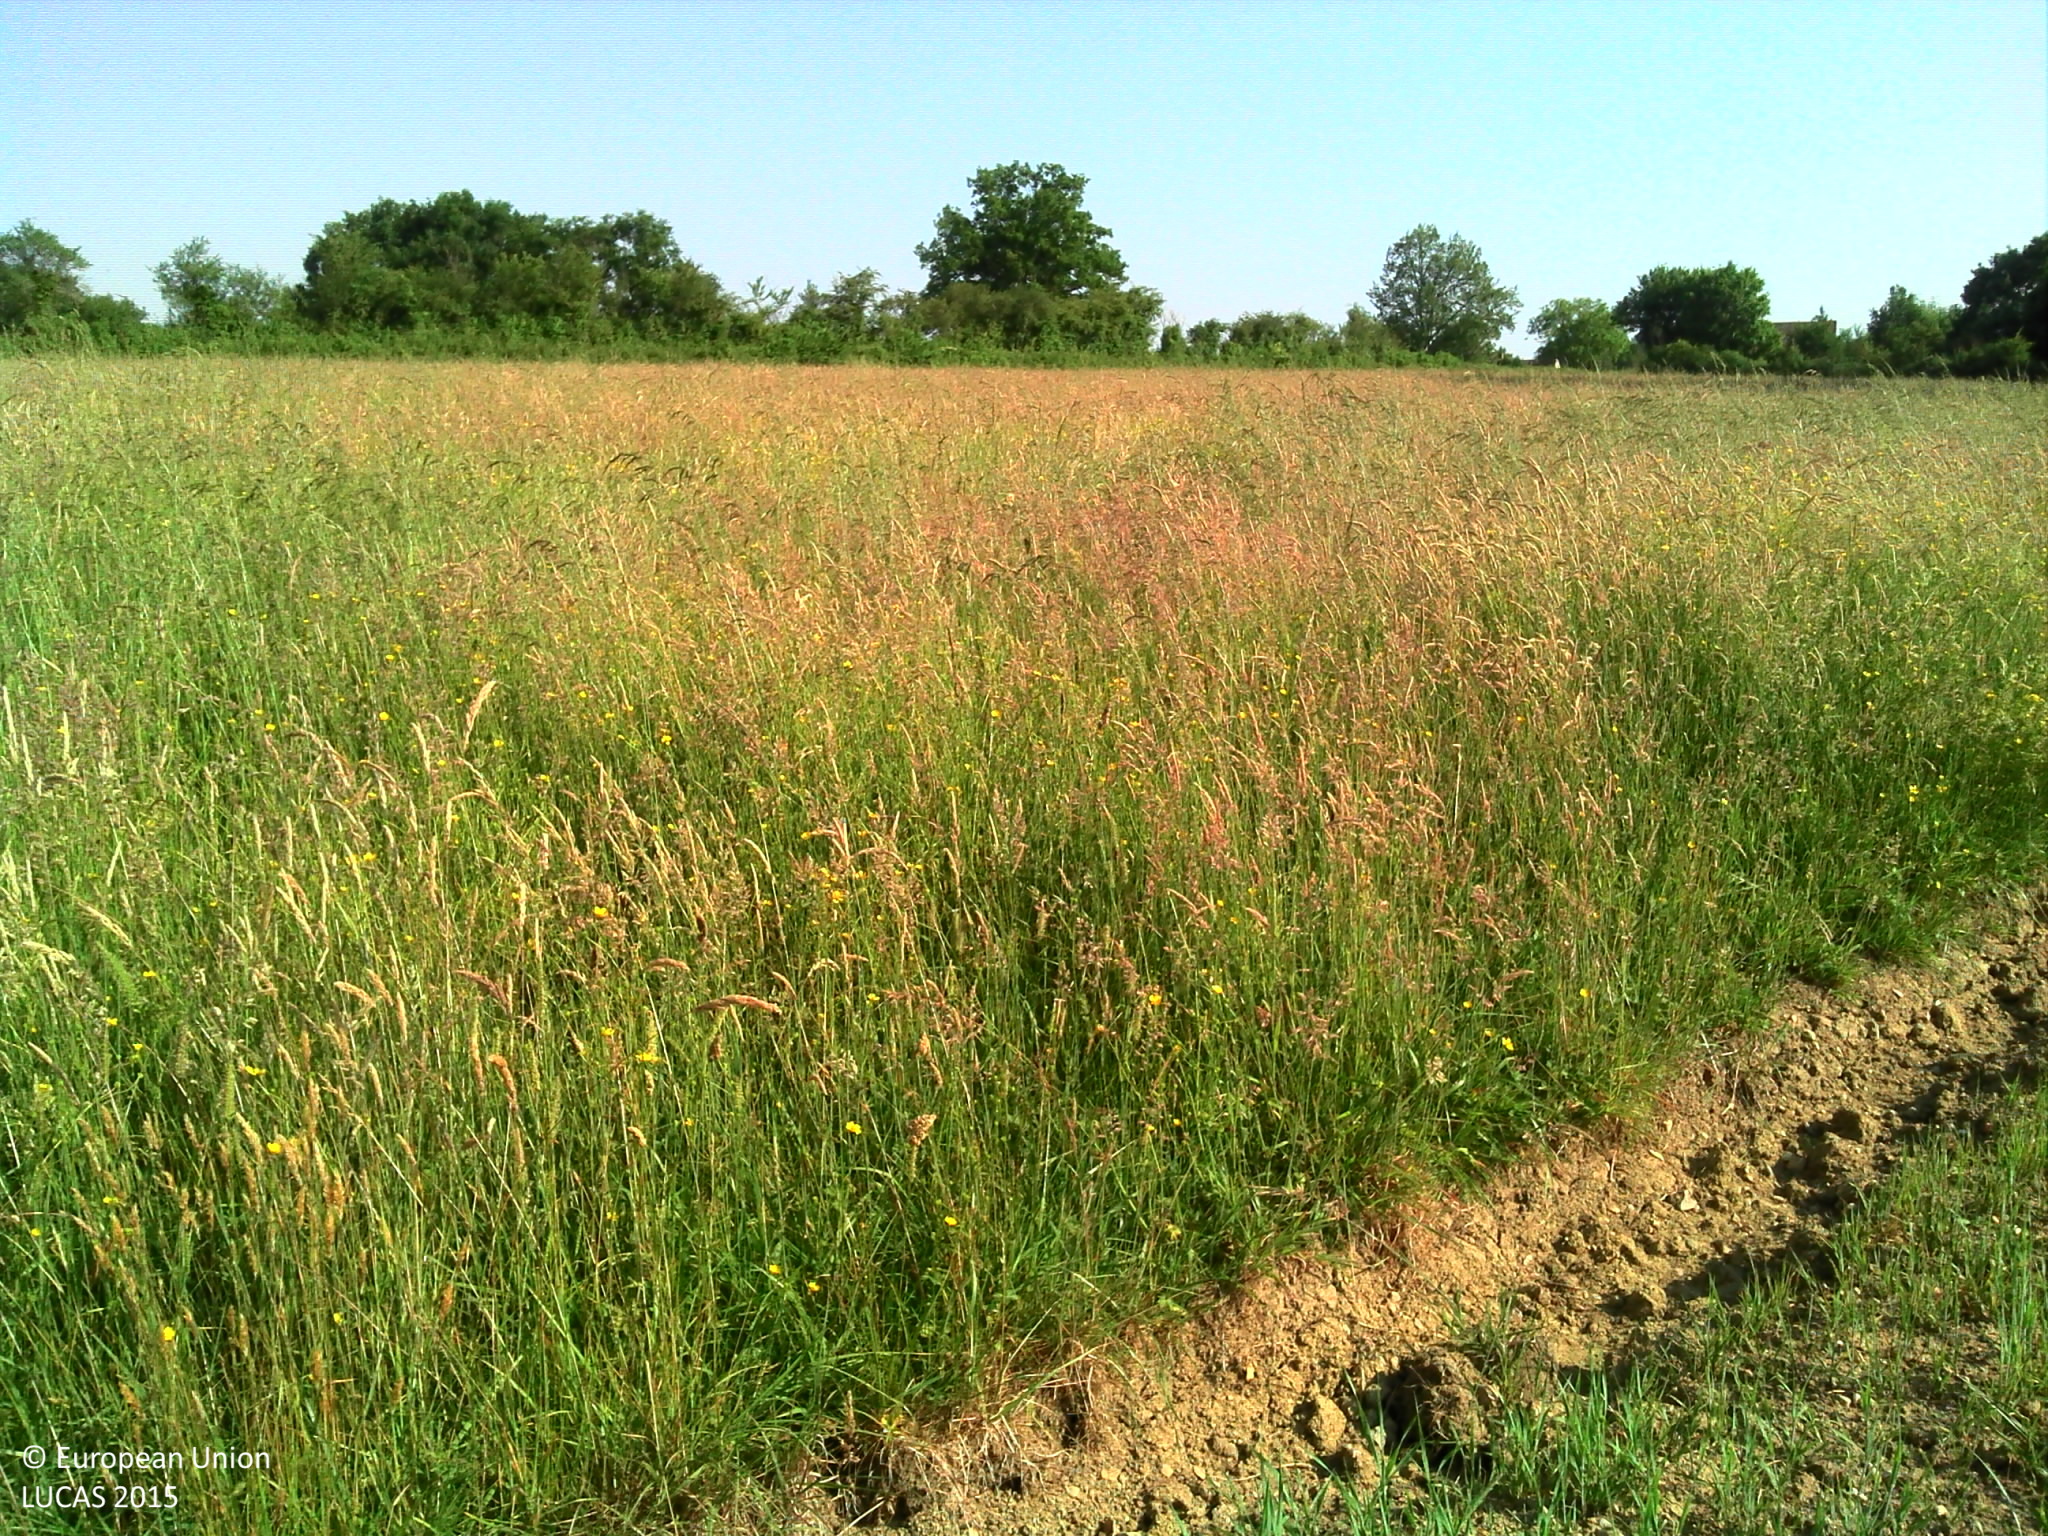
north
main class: Cropland
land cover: Barley
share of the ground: > 75 %
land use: Agriculture (excluding fallow land and kitchen gardens)
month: June
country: FR
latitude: 46.7527
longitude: 2.7035
